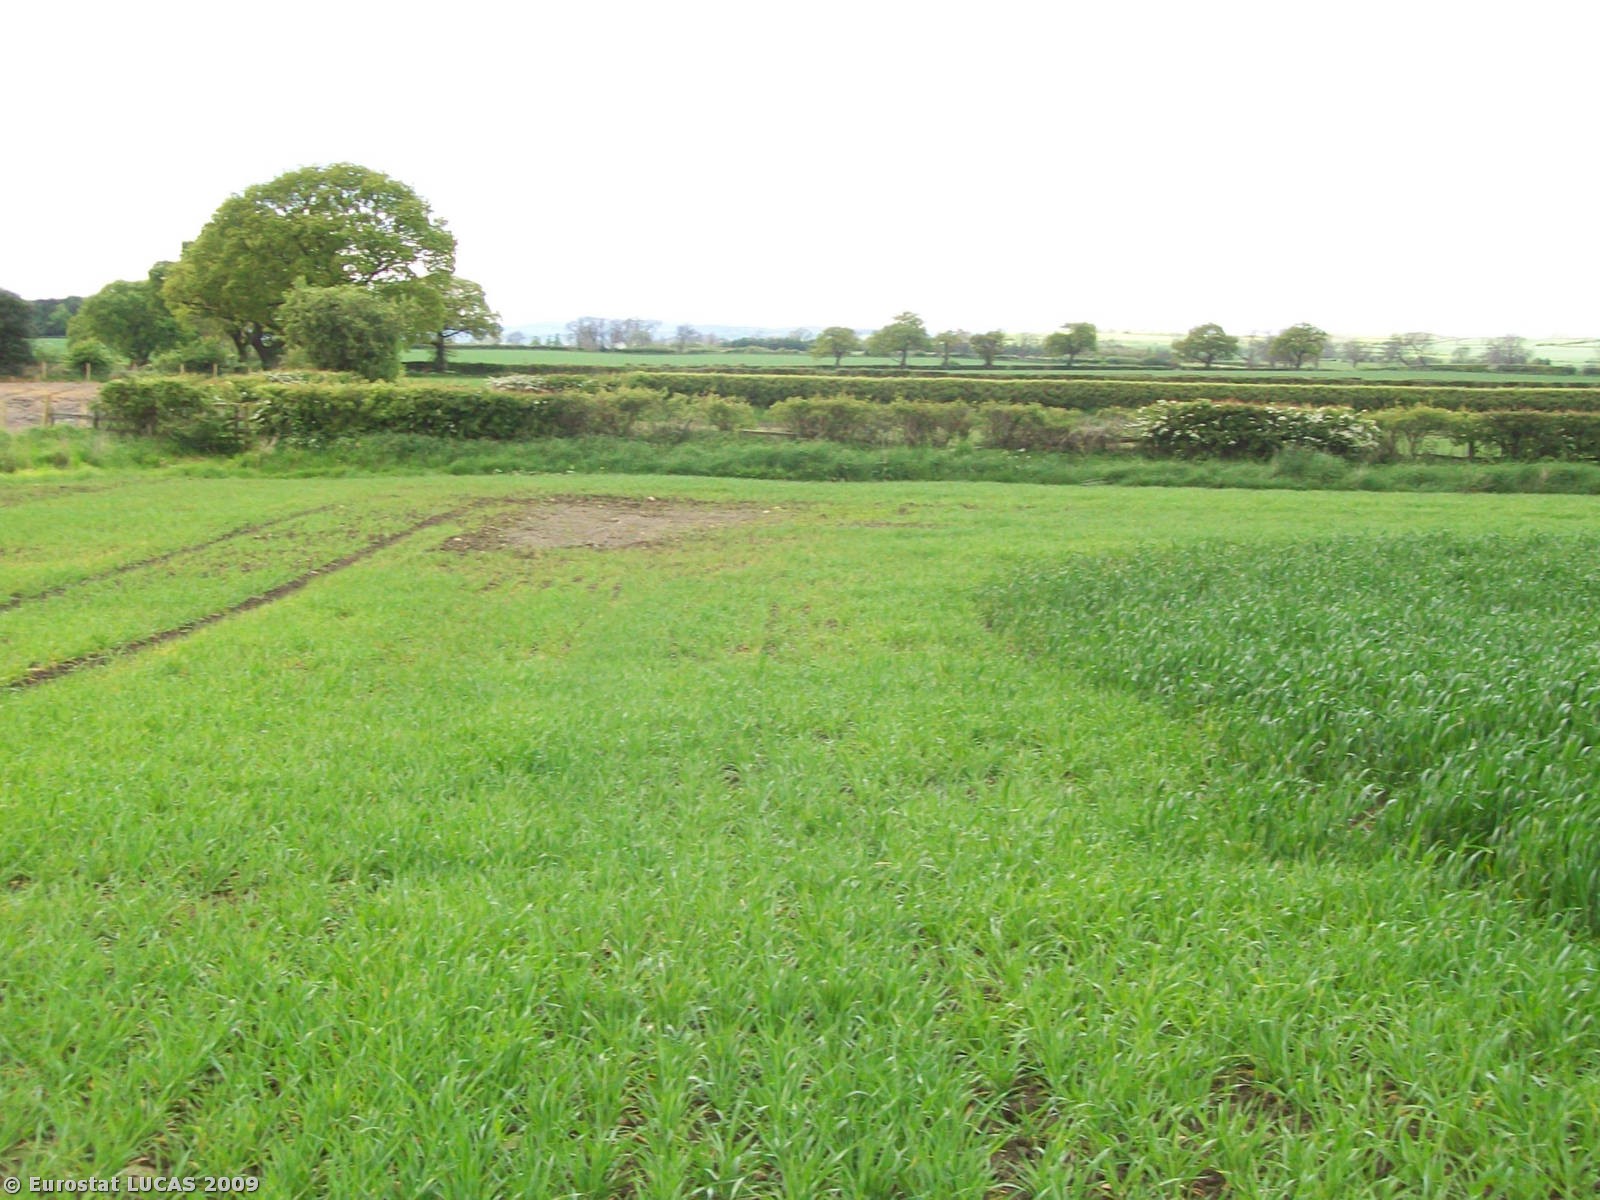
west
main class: Cropland
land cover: Barley
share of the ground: < 10 %
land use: Agriculture (excluding fallow land and kitchen gardens)
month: May
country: GB
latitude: 54.5804
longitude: -1.6700
